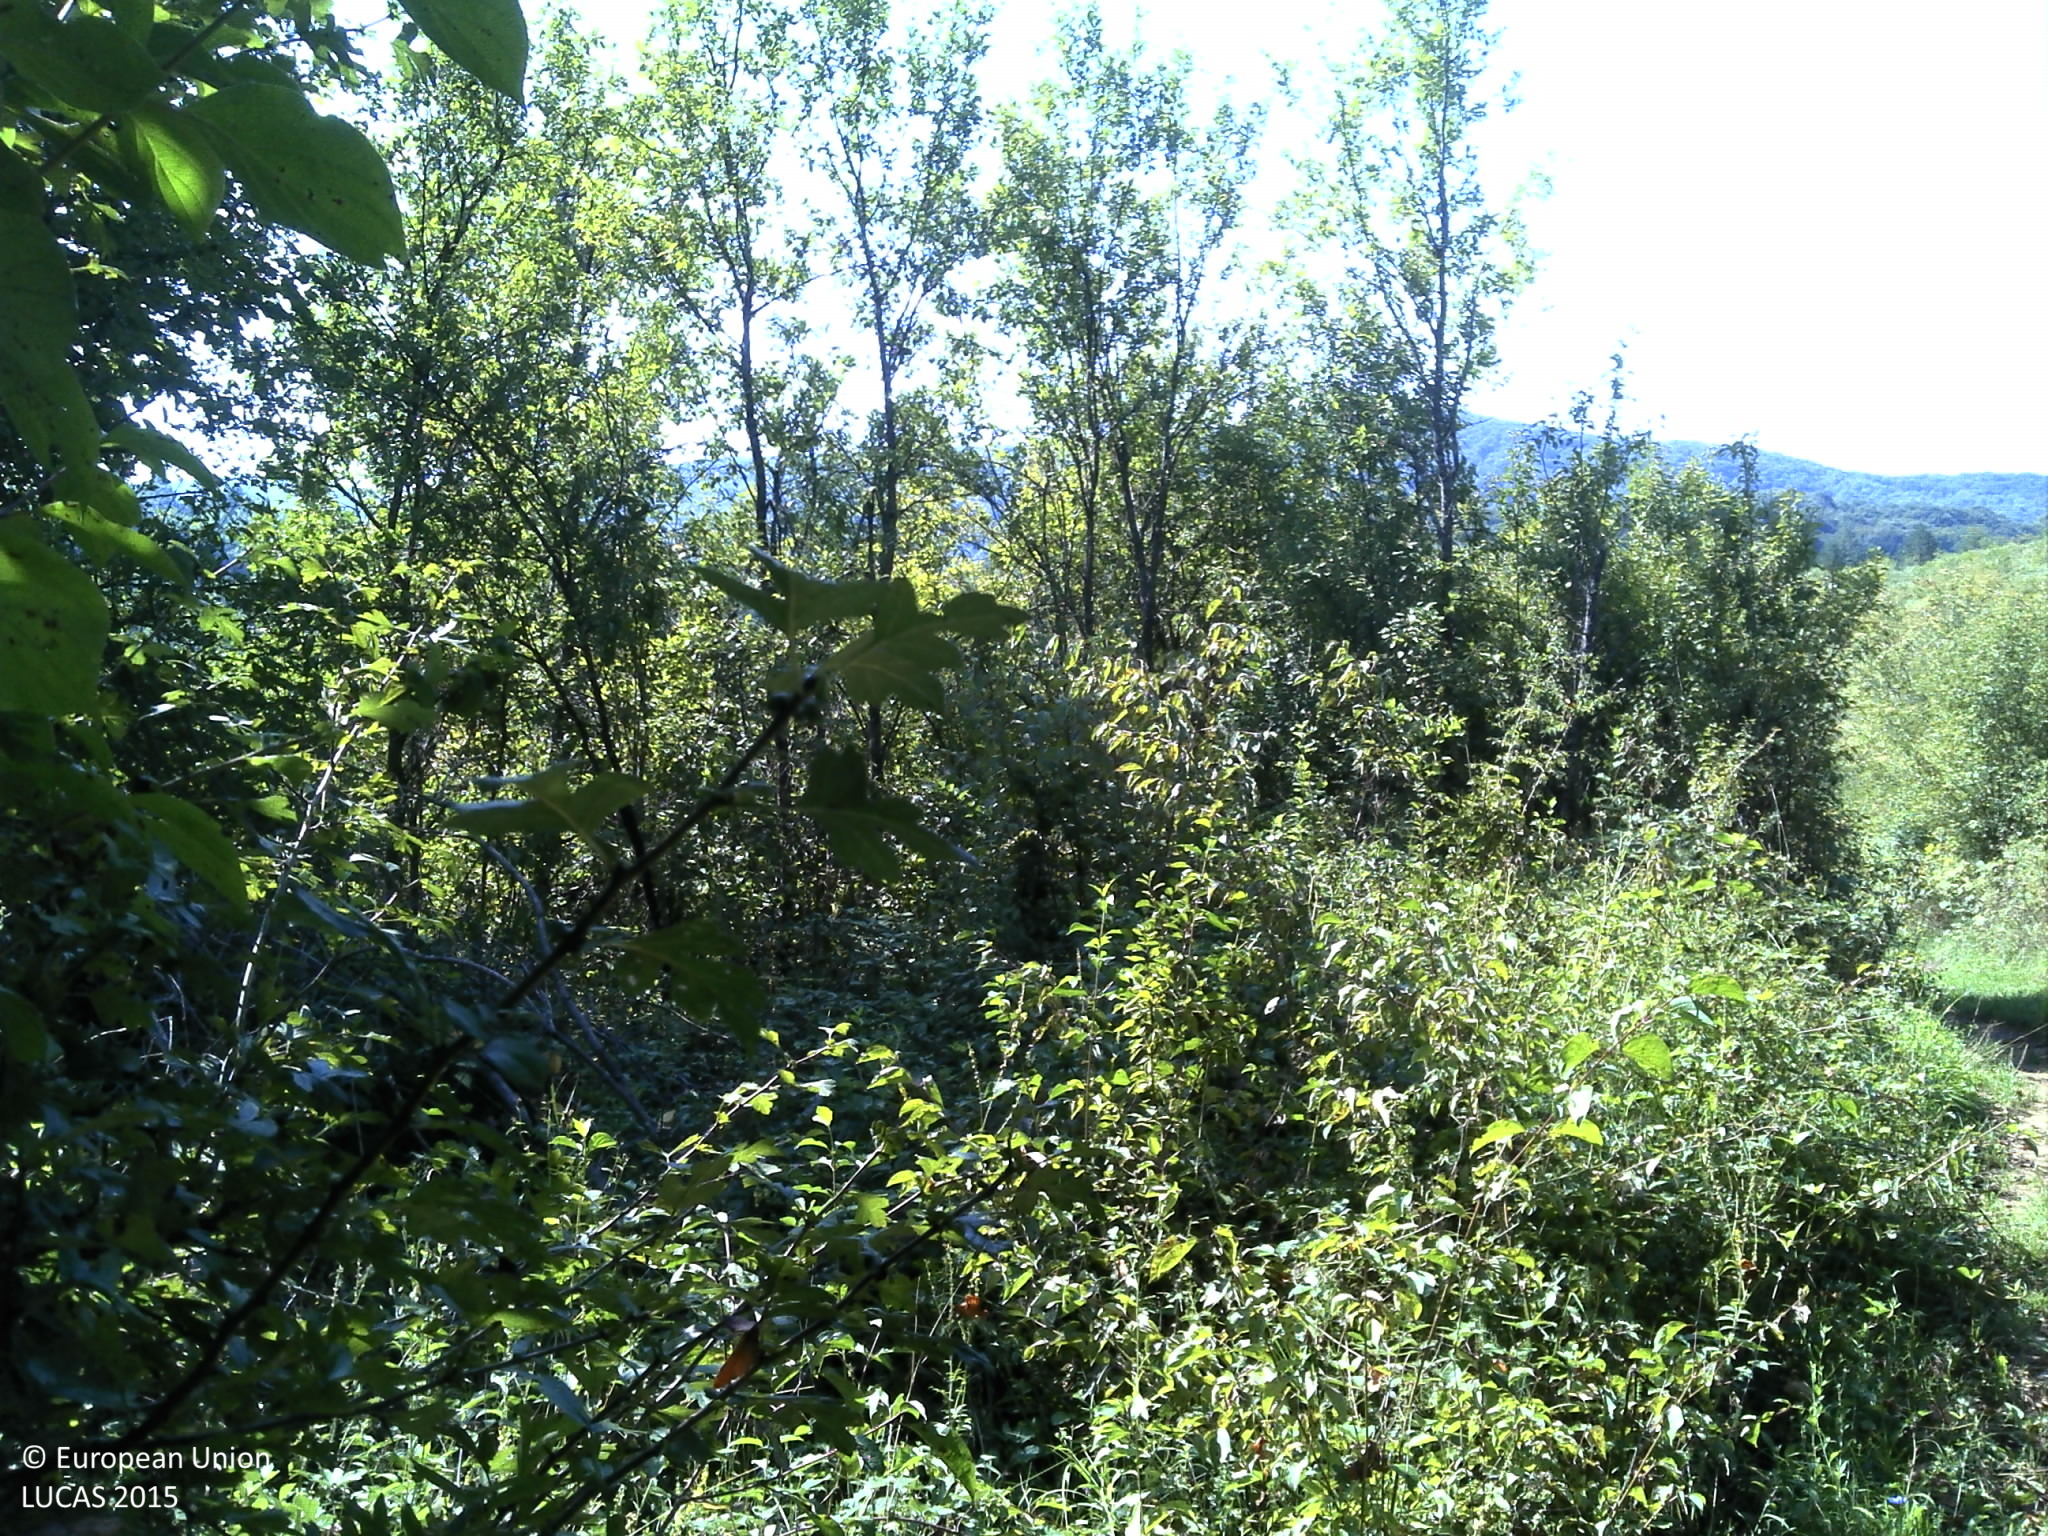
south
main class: Woodland
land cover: Broadleaved woodland
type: acidophilous oak and oak-birch forest
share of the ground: > 75 %
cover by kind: broadleaved forest trees 95 %, shrubs 5 %
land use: Semi-natural and natural areas not in use
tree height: > 5 m
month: August
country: HR
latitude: 45.0849
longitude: 15.5979
